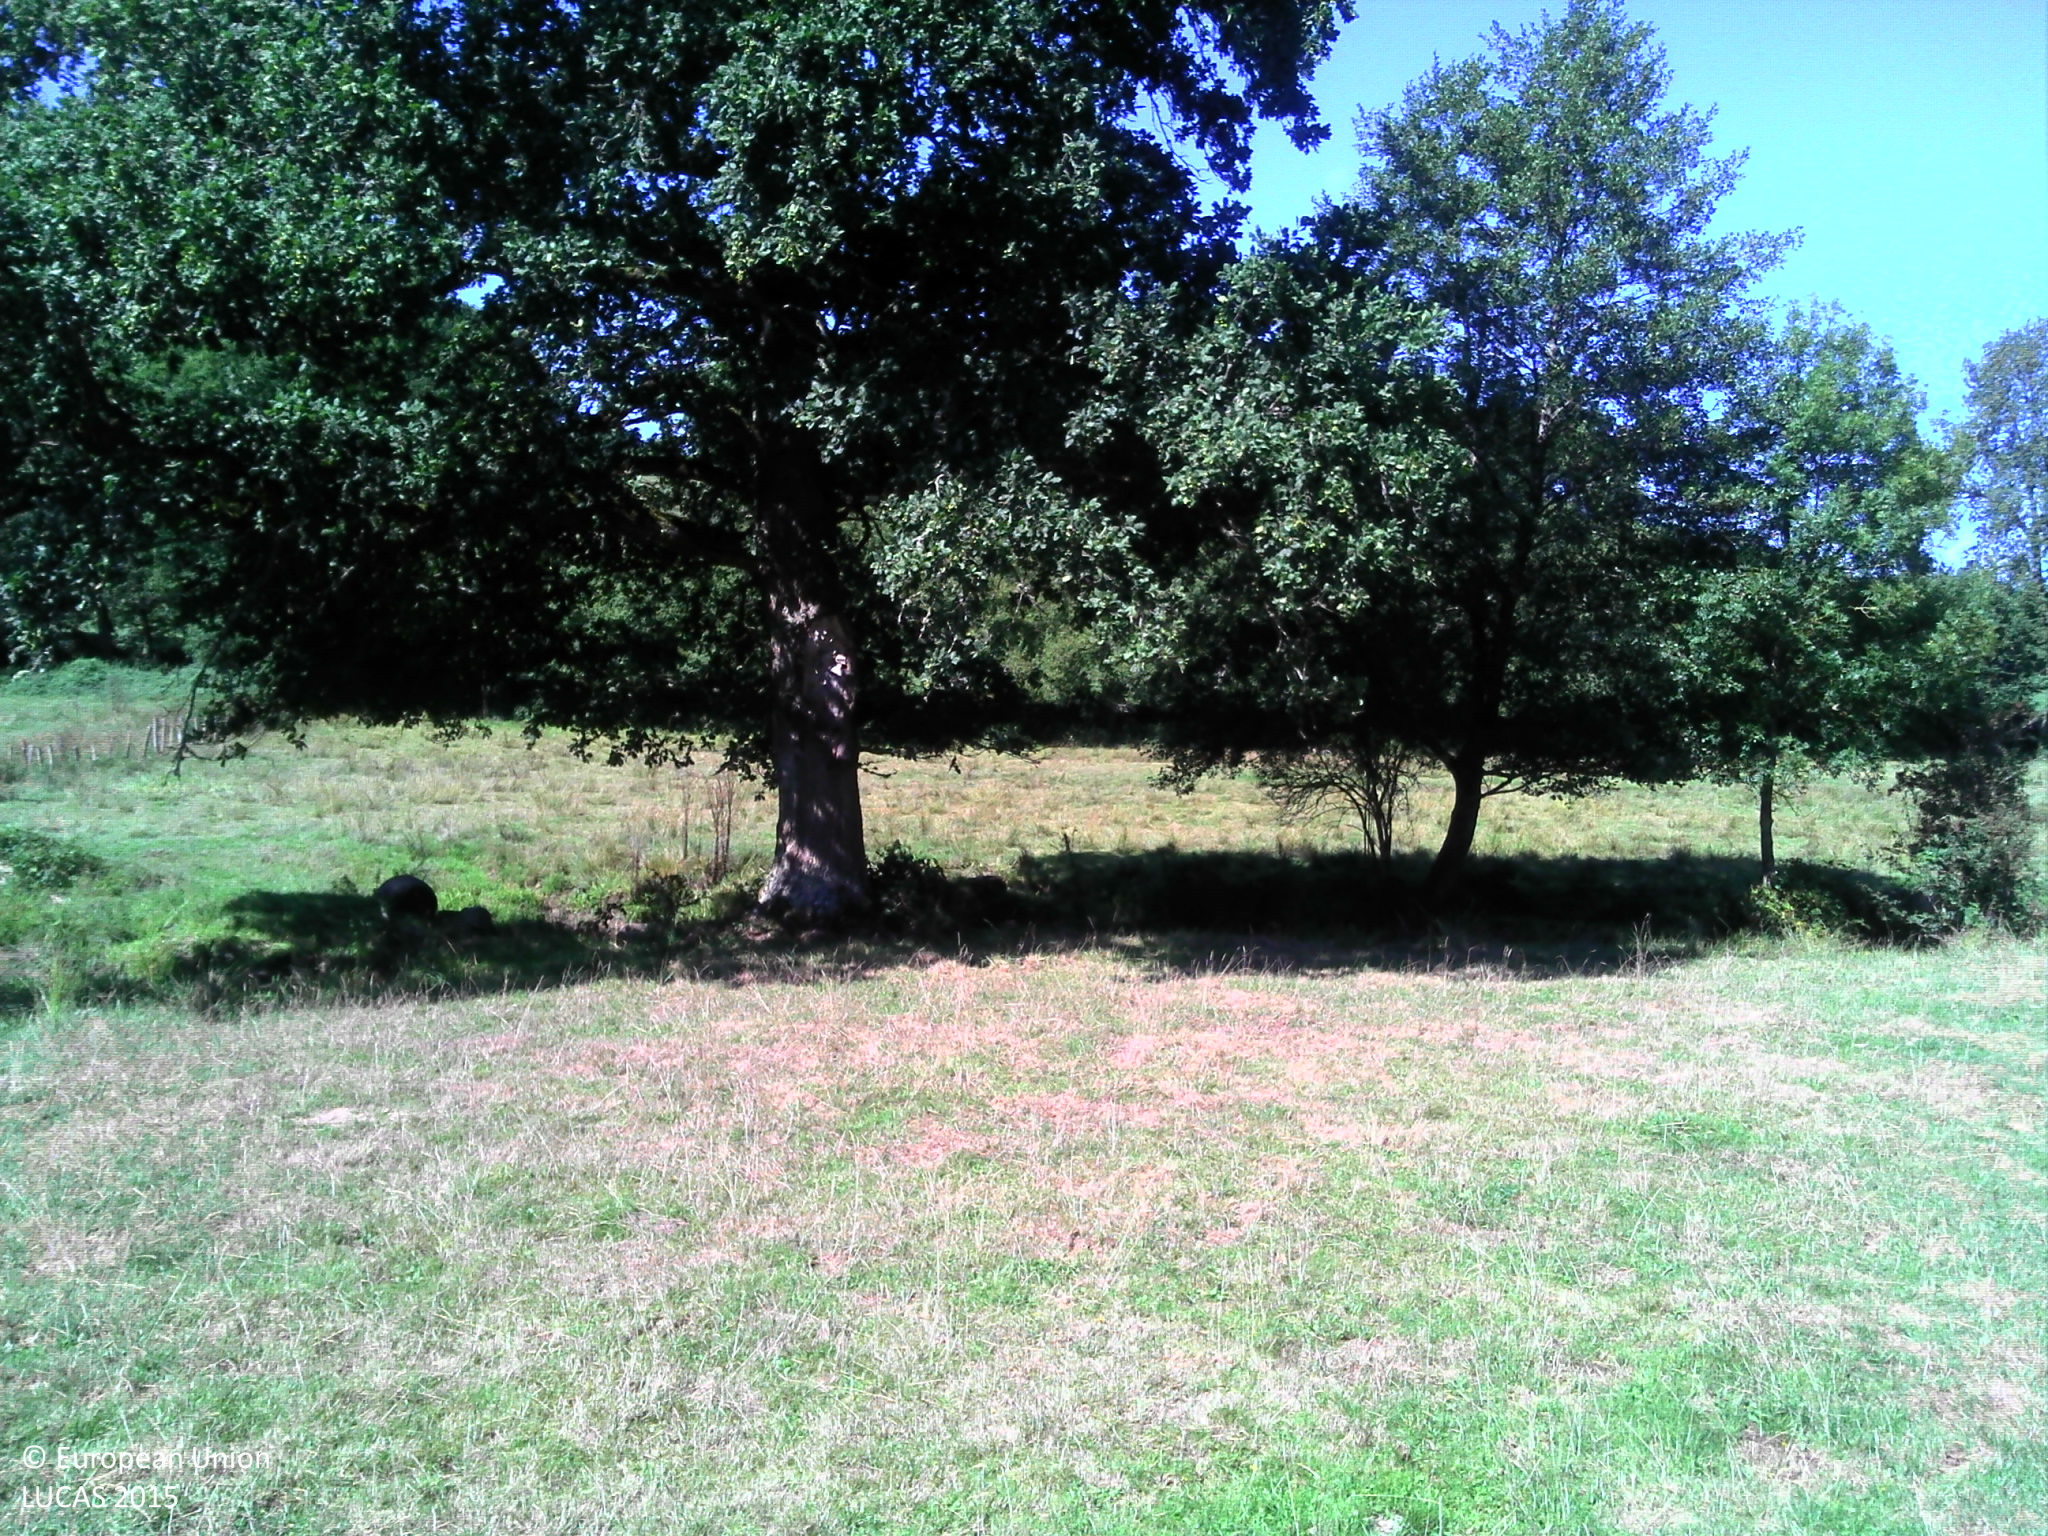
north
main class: Grassland
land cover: Grassland without tree/shrub cover
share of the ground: > 75 %
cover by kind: herbaceous plants 100 %
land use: Agriculture (excluding fallow land and kitchen gardens)
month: August
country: FR
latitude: 45.8710
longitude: 2.2537
